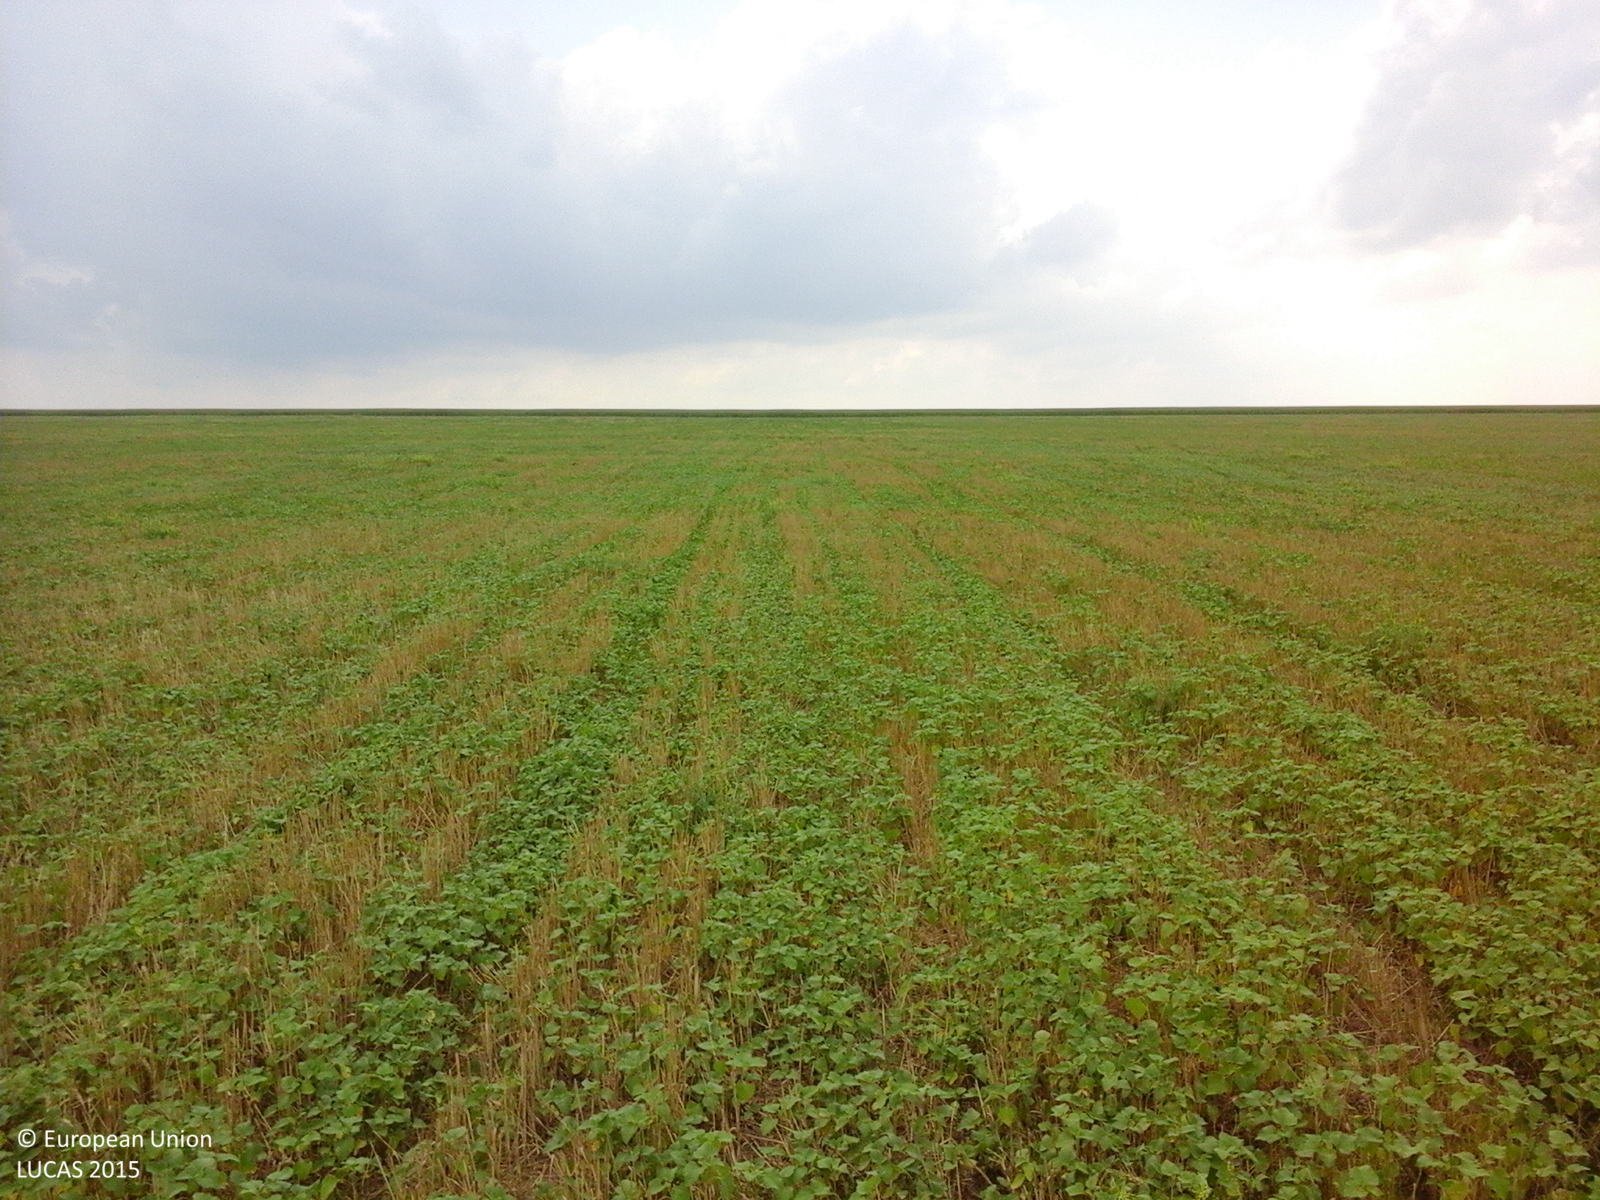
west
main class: Cropland
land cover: Common wheat
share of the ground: > 75 %
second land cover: Spontaneously vegetated surfaces
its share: 50 - 75 %
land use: Agriculture (excluding fallow land and kitchen gardens)
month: July
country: RO
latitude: 44.9579
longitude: 28.8115
